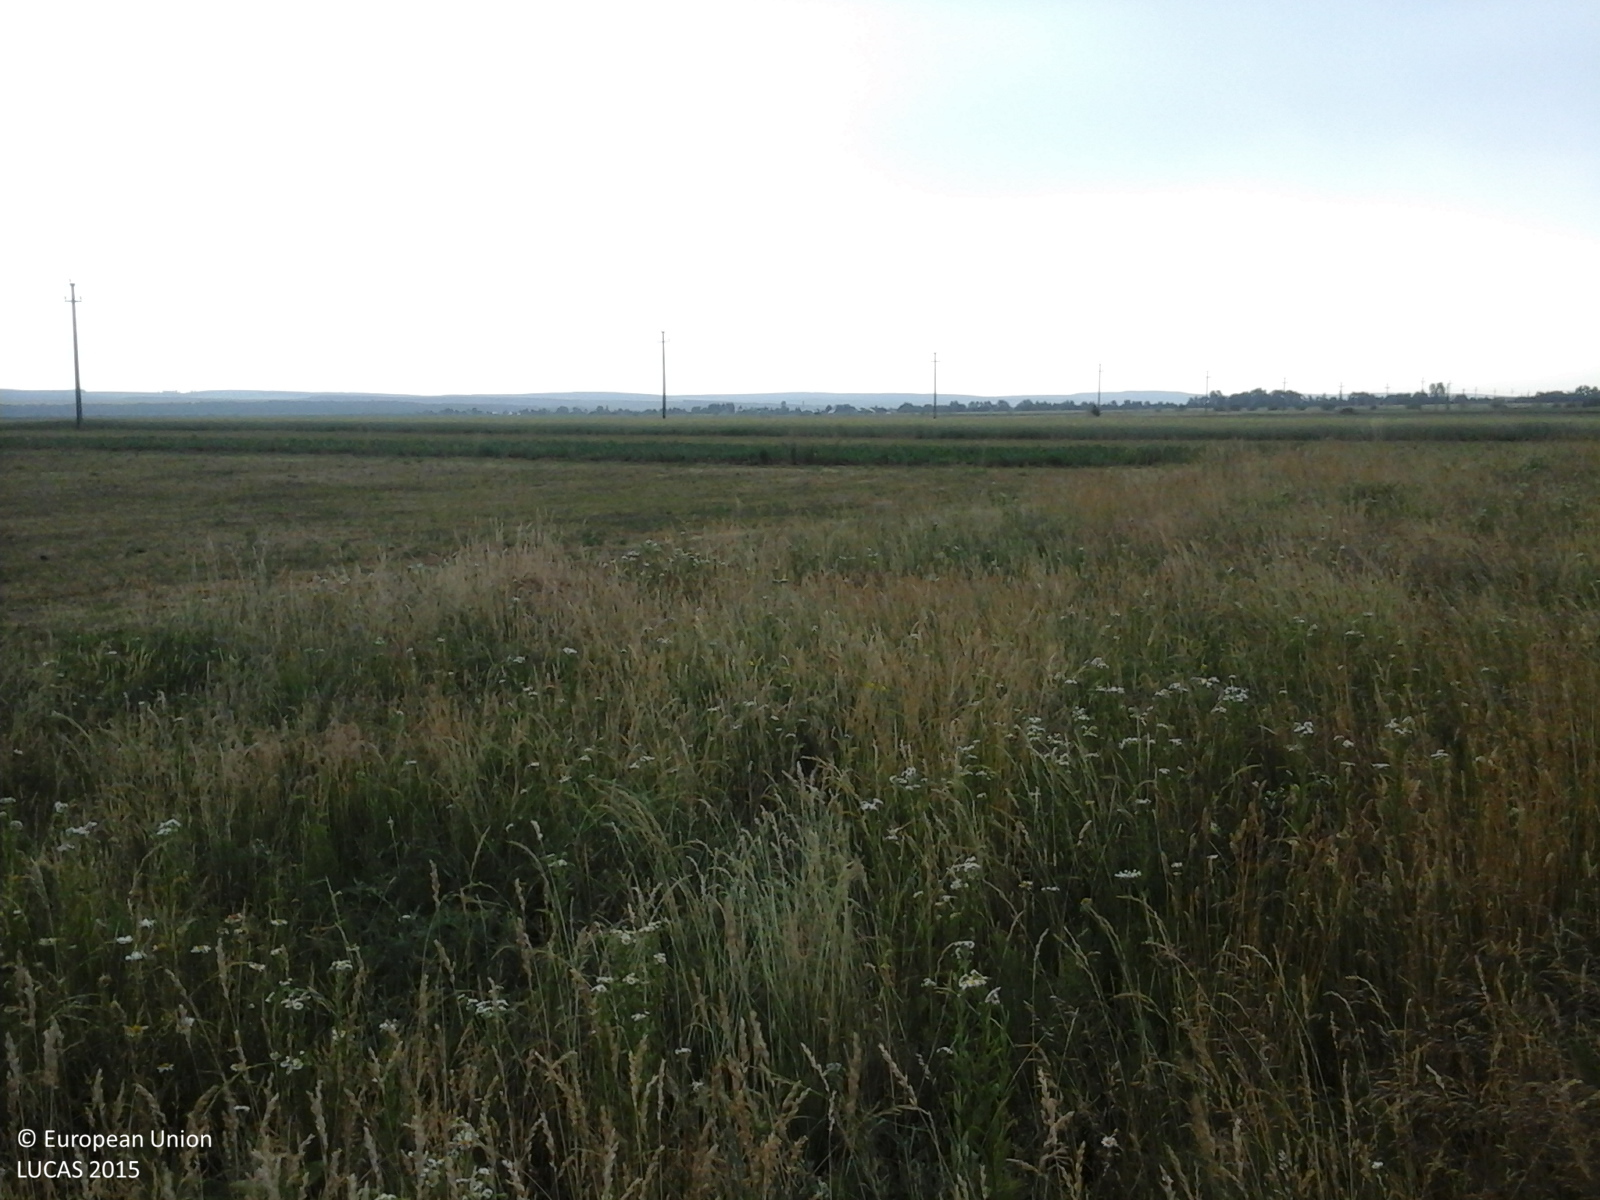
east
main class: Grassland
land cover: Grassland without tree/shrub cover
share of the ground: > 75 %
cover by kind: herbaceous plants 100 %
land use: Agriculture (excluding fallow land and kitchen gardens)
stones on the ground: < 10 %
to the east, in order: Grassland without tree/shrub cover; Lucerne; Maize; Lucerne; Rye; Maize; Electric lines; Maize; Oats; Maize; Ditches and canals; Maize; Lucerne
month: June
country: RO
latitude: 47.2723
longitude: 26.4367
